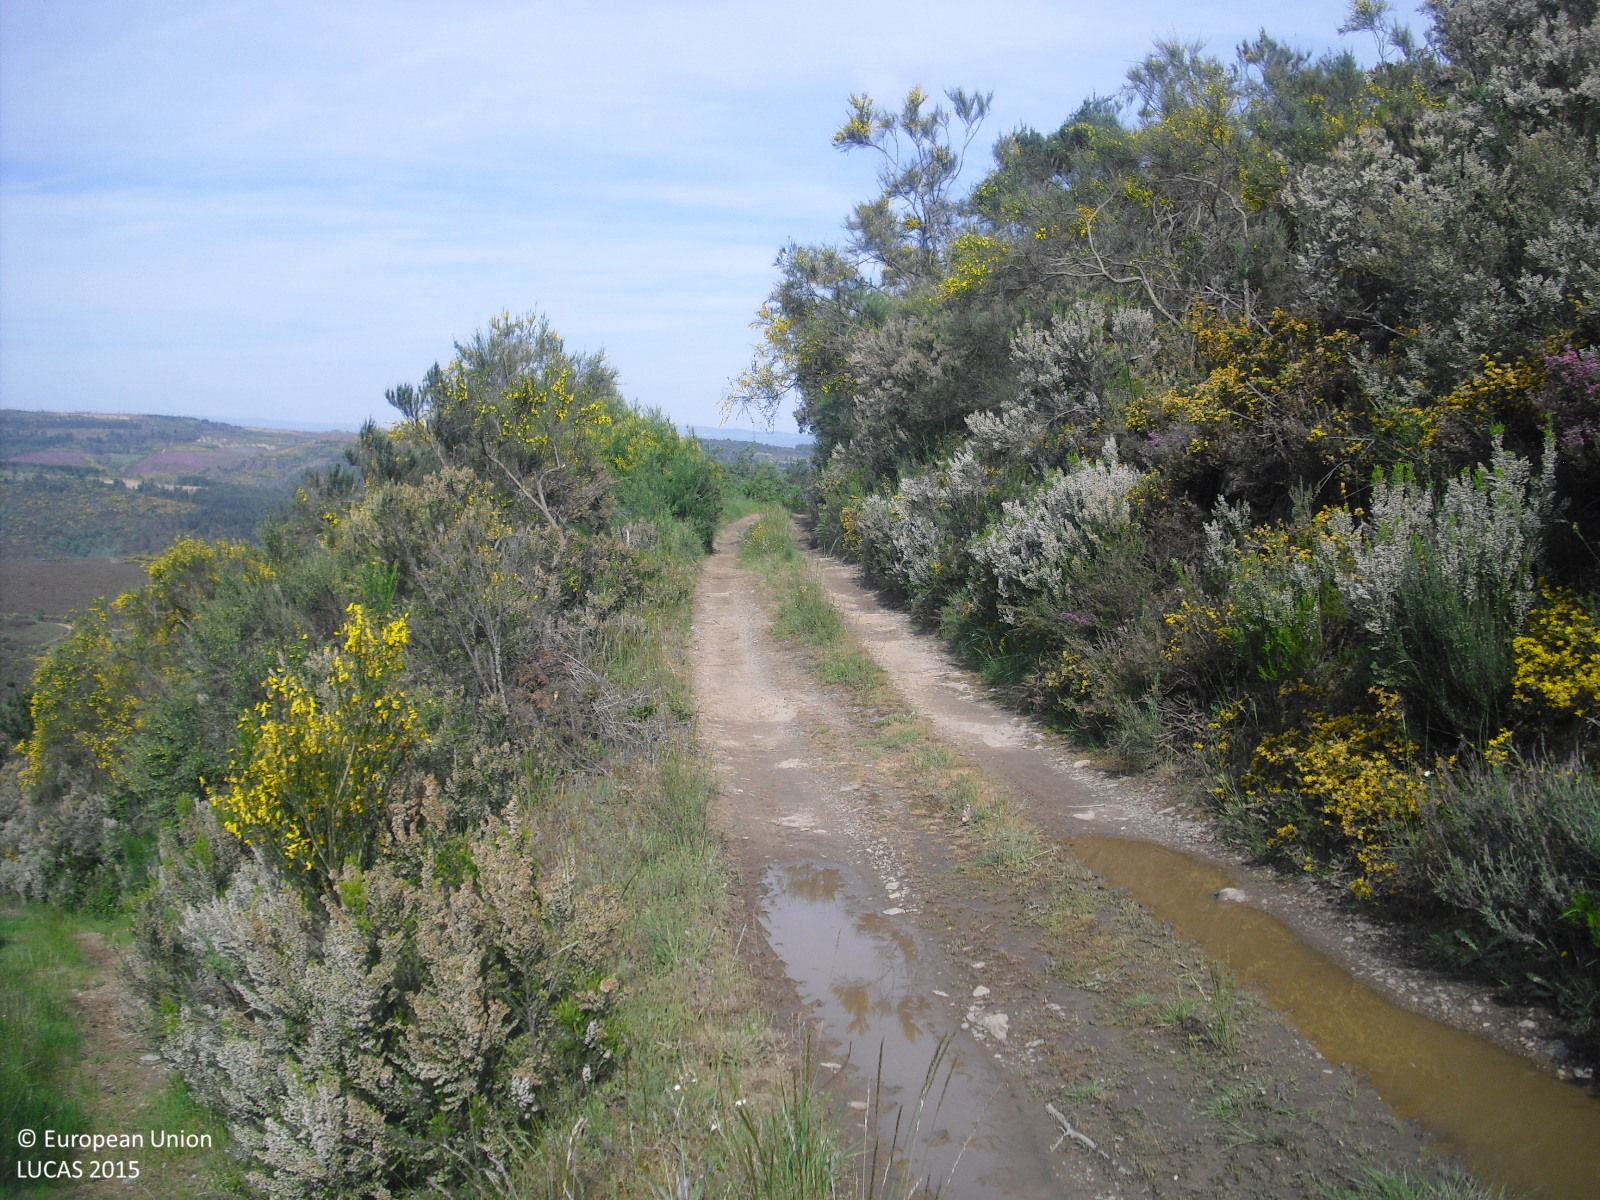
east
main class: Shrubland
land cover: Shrubland without tree cover
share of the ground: > 75 %
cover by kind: shrubs 100 %
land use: Semi-natural and natural areas not in use
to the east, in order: Shrubland without tree cover; Dry stone walls; Shrubland without tree cover; Tracks; Shruby margins; Dry stone walls; Tracks; Shruby margins; Nuts trees; Shruby margins; Vineyards; Shrubland without tree cover; Single bushes/trees; Shrubland without tree cover; Dry stone walls; Grass margins; Tracks; Grass margins; Dry stone walls; Shrubland without tree cover; Shrubland with sparse tree cover
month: May
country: ES
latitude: 41.8754
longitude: -7.2732
